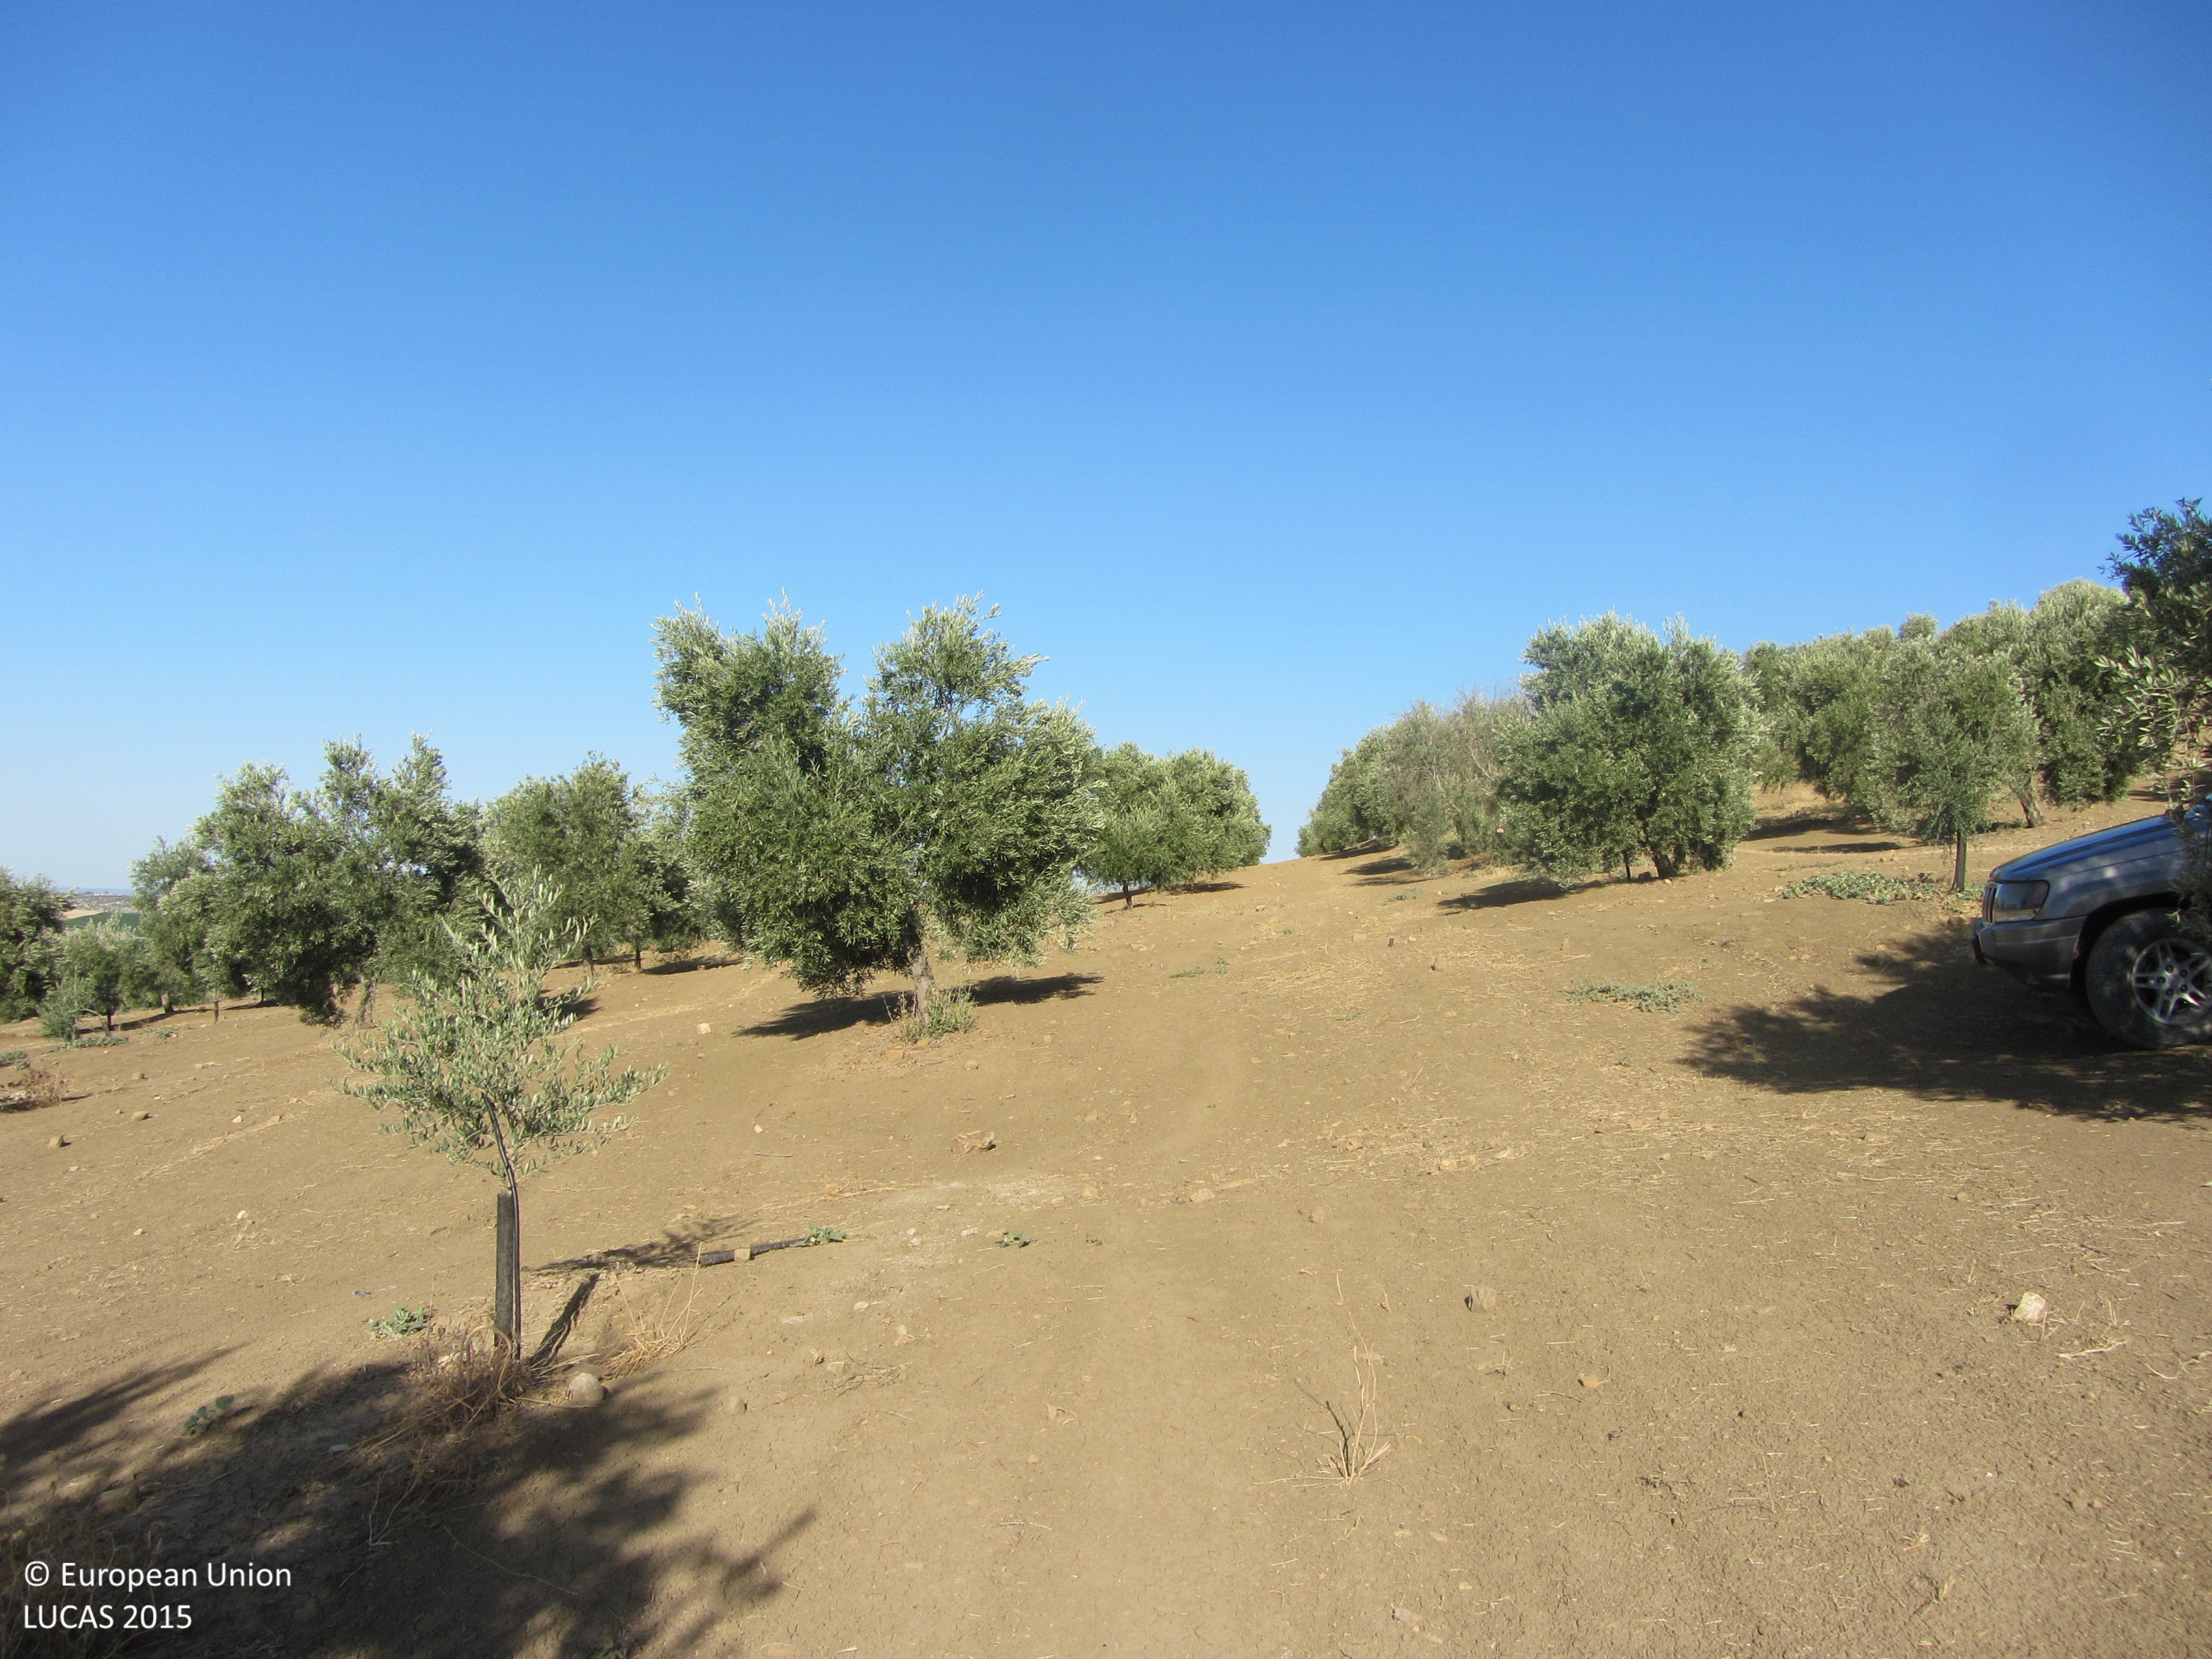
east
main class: Cropland
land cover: Olive groves
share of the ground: 25 - 50 %
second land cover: Other bare soil
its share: > 75 %
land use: Agriculture (excluding fallow land and kitchen gardens)
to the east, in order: Olive groves; Other bare soil; Other structural elements; Olive groves
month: July
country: ES
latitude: 37.9405
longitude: -3.8519
